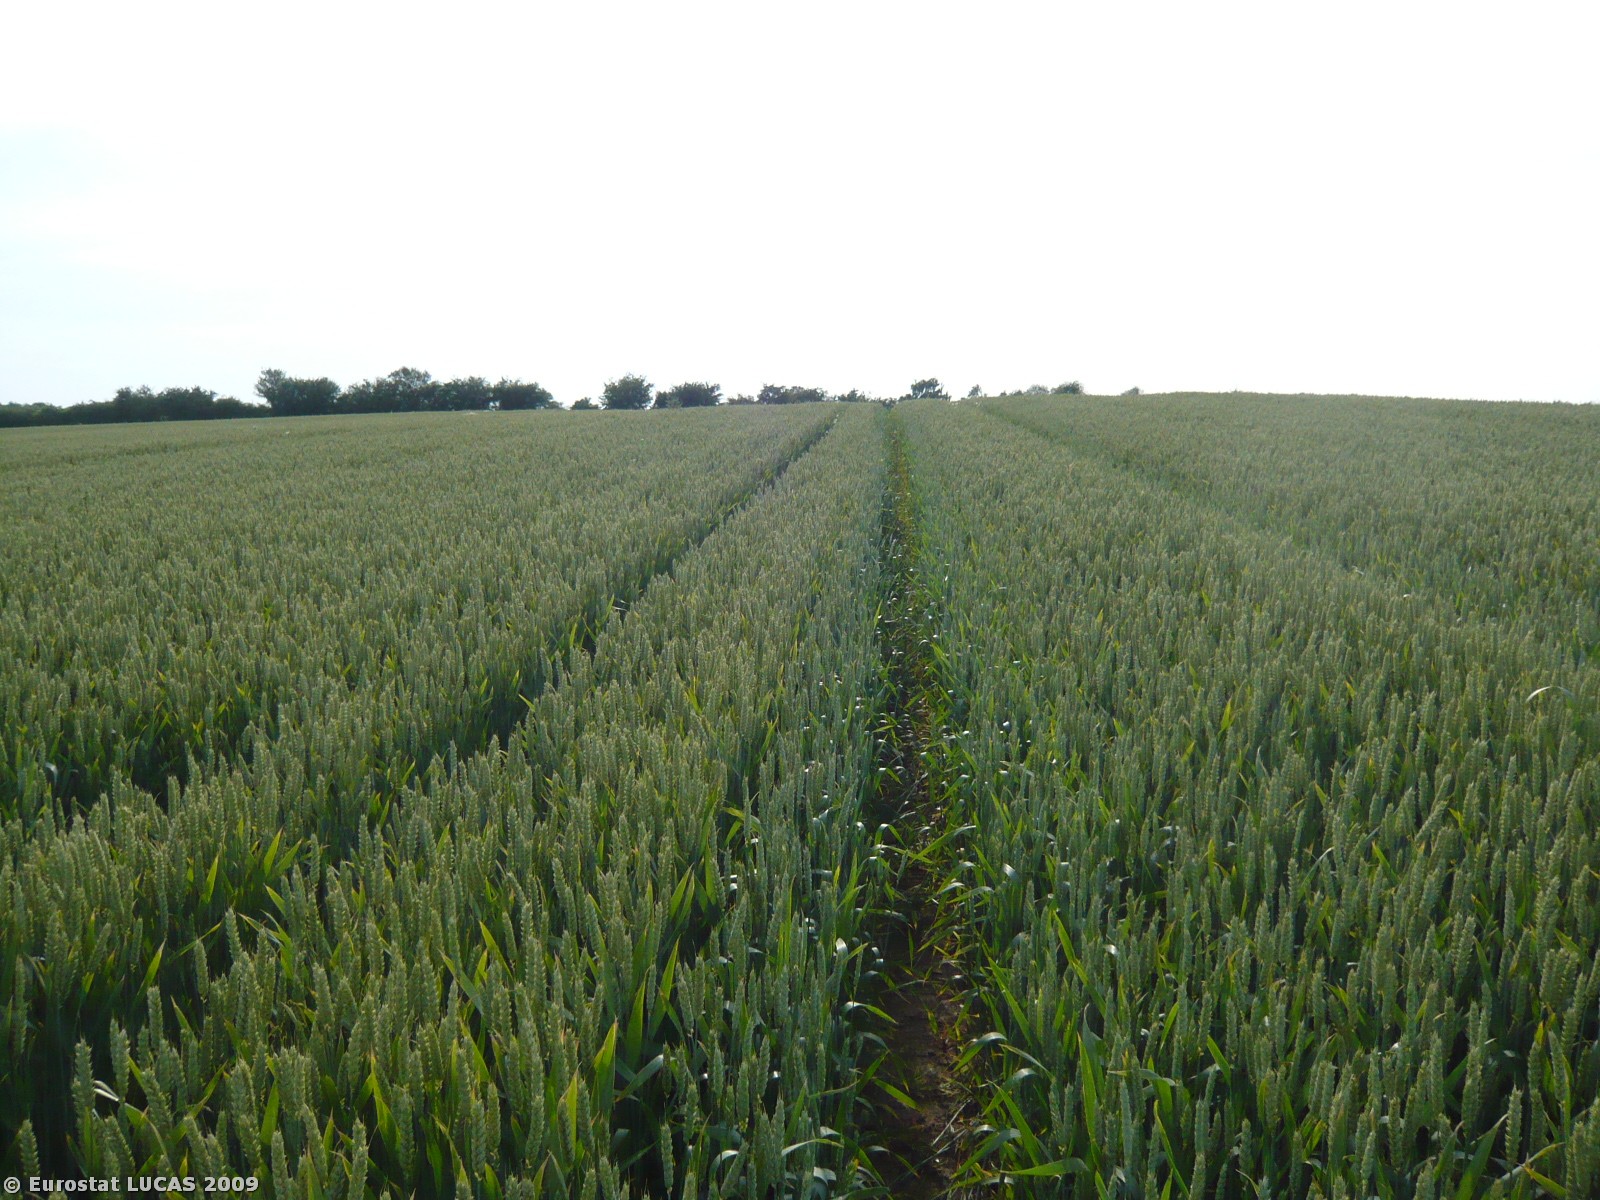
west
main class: Cropland
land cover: Common wheat
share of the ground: > 75 %
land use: Agriculture (excluding fallow land and kitchen gardens)
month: June
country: DK
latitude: 55.1630
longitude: 10.2039
